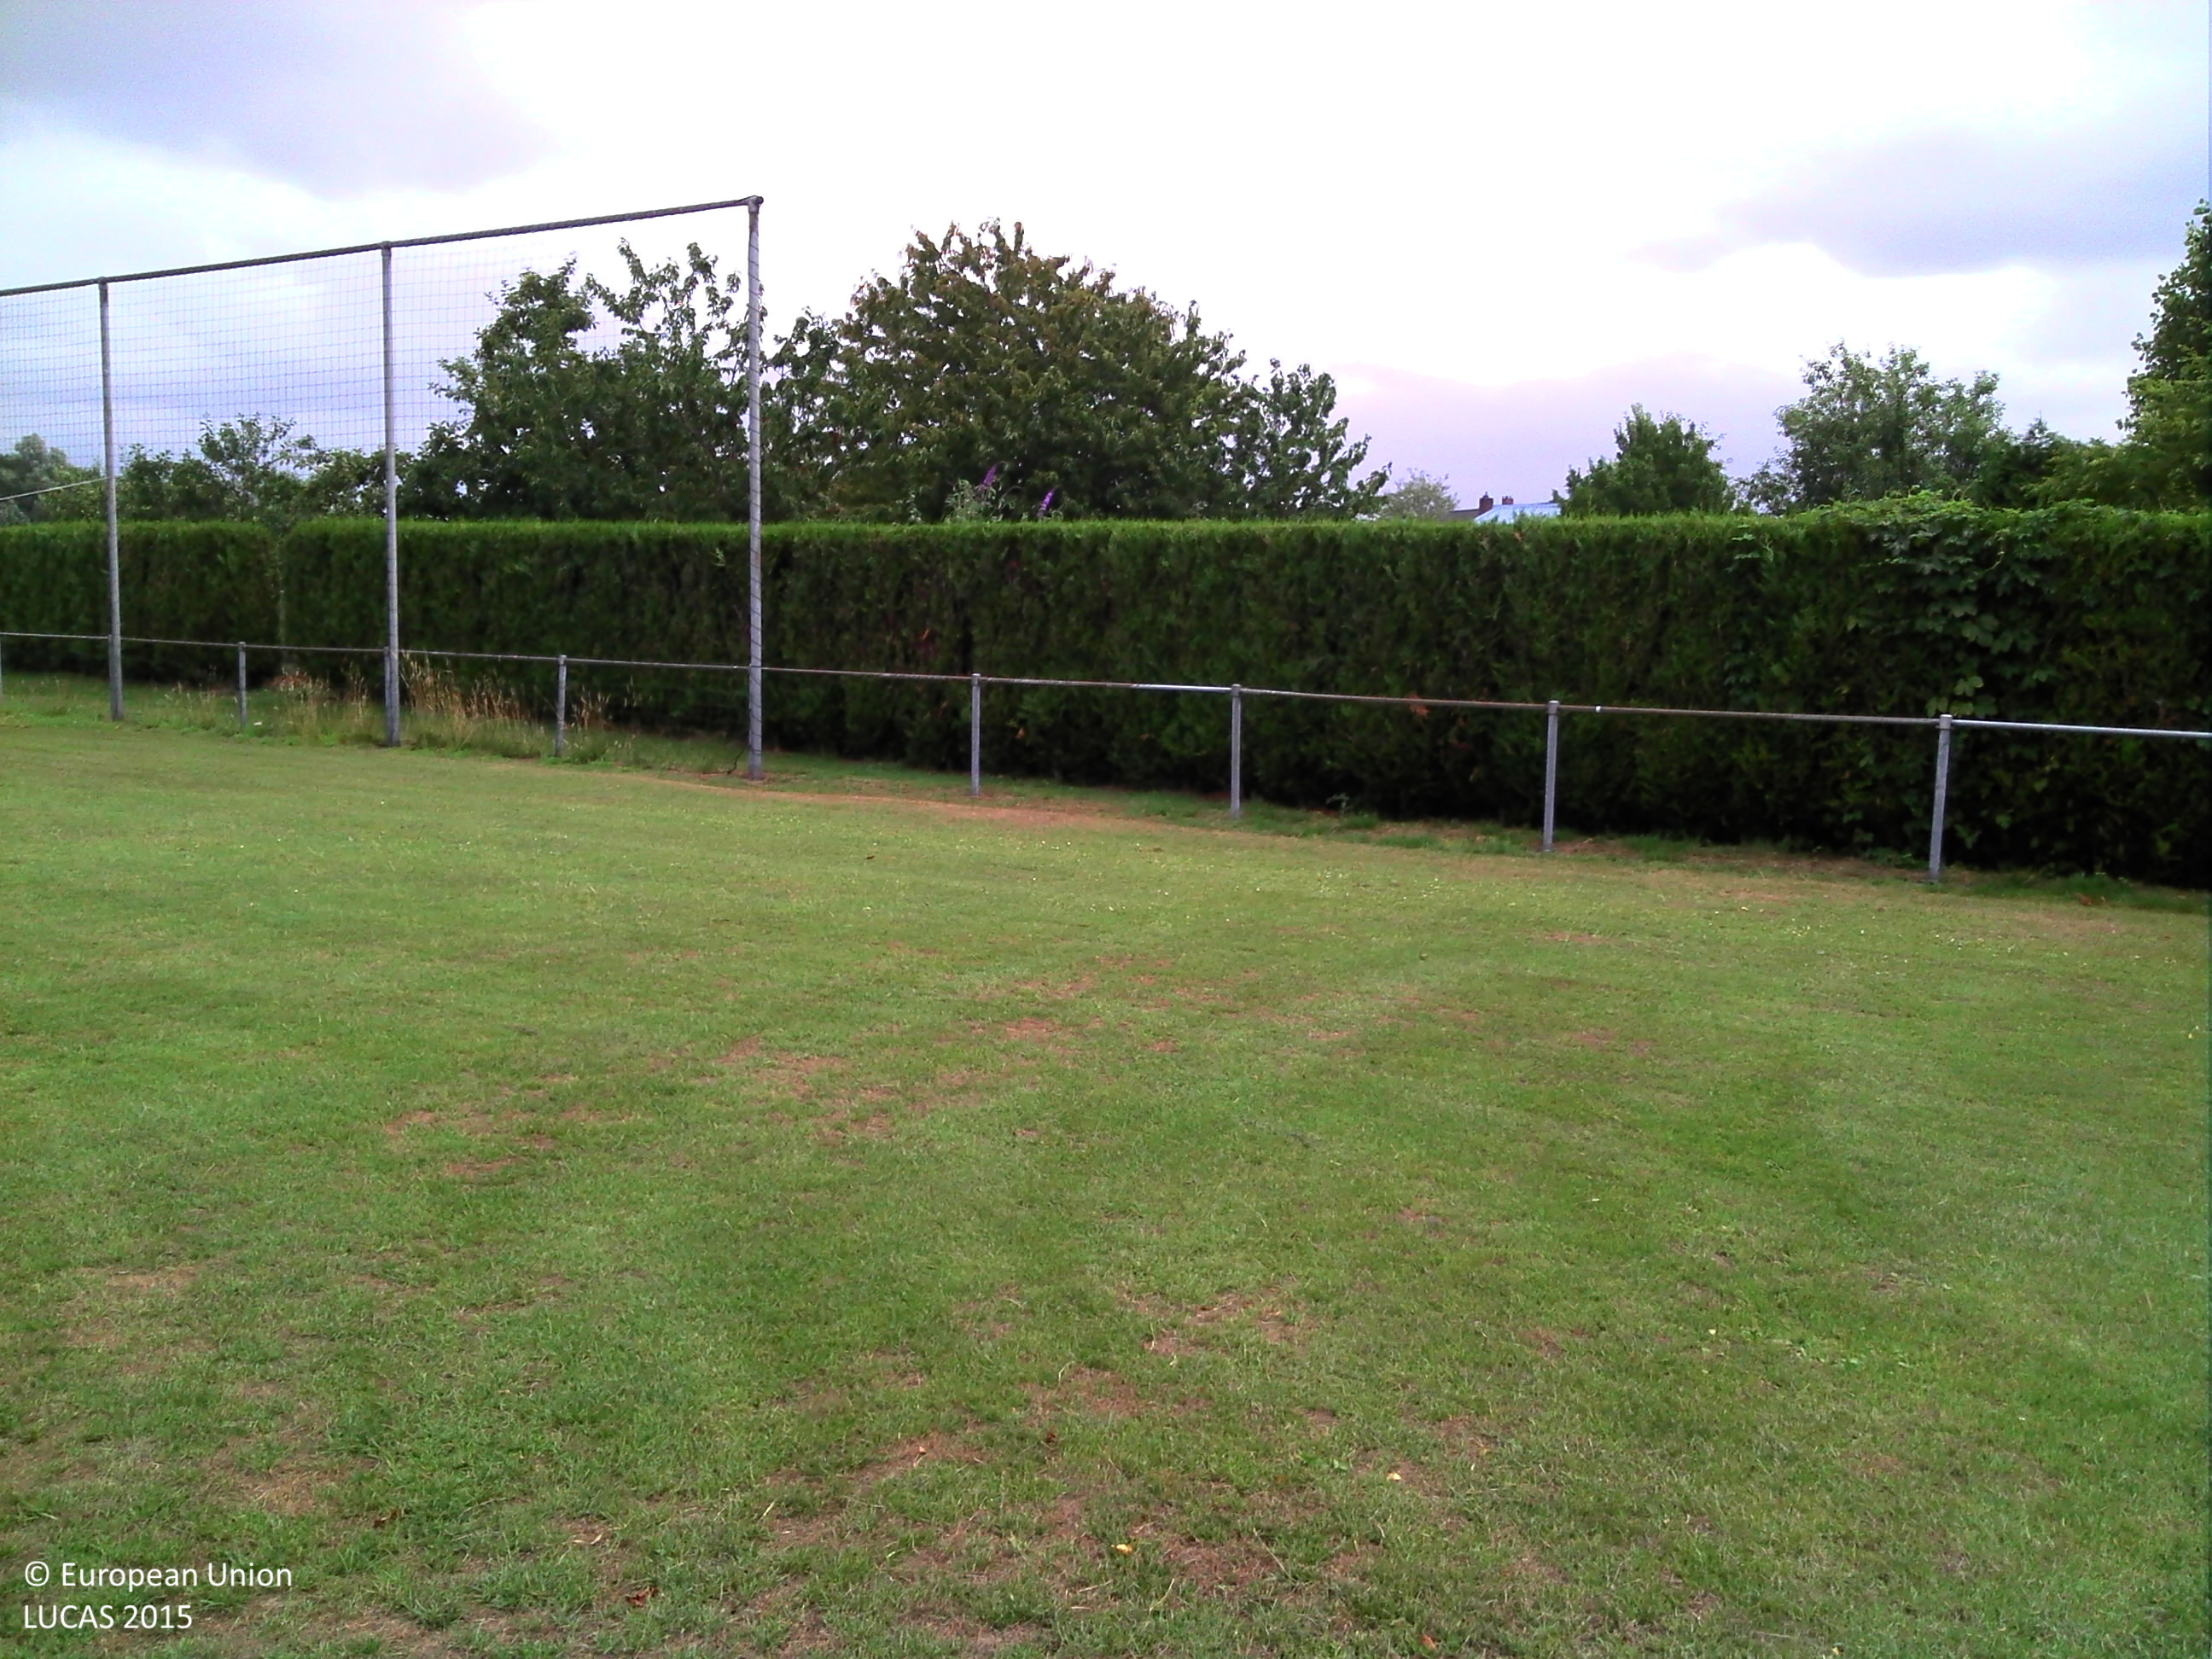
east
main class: Grassland
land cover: Grassland without tree/shrub cover
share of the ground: > 75 %
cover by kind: herbaceous plants 100 %
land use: Sport
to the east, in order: Grassland without tree/shrub cover; Artificial constructions in urban areas; Maize; Artificial constructions in urban areas
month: July
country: BE
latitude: 51.2485
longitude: 5.5140
